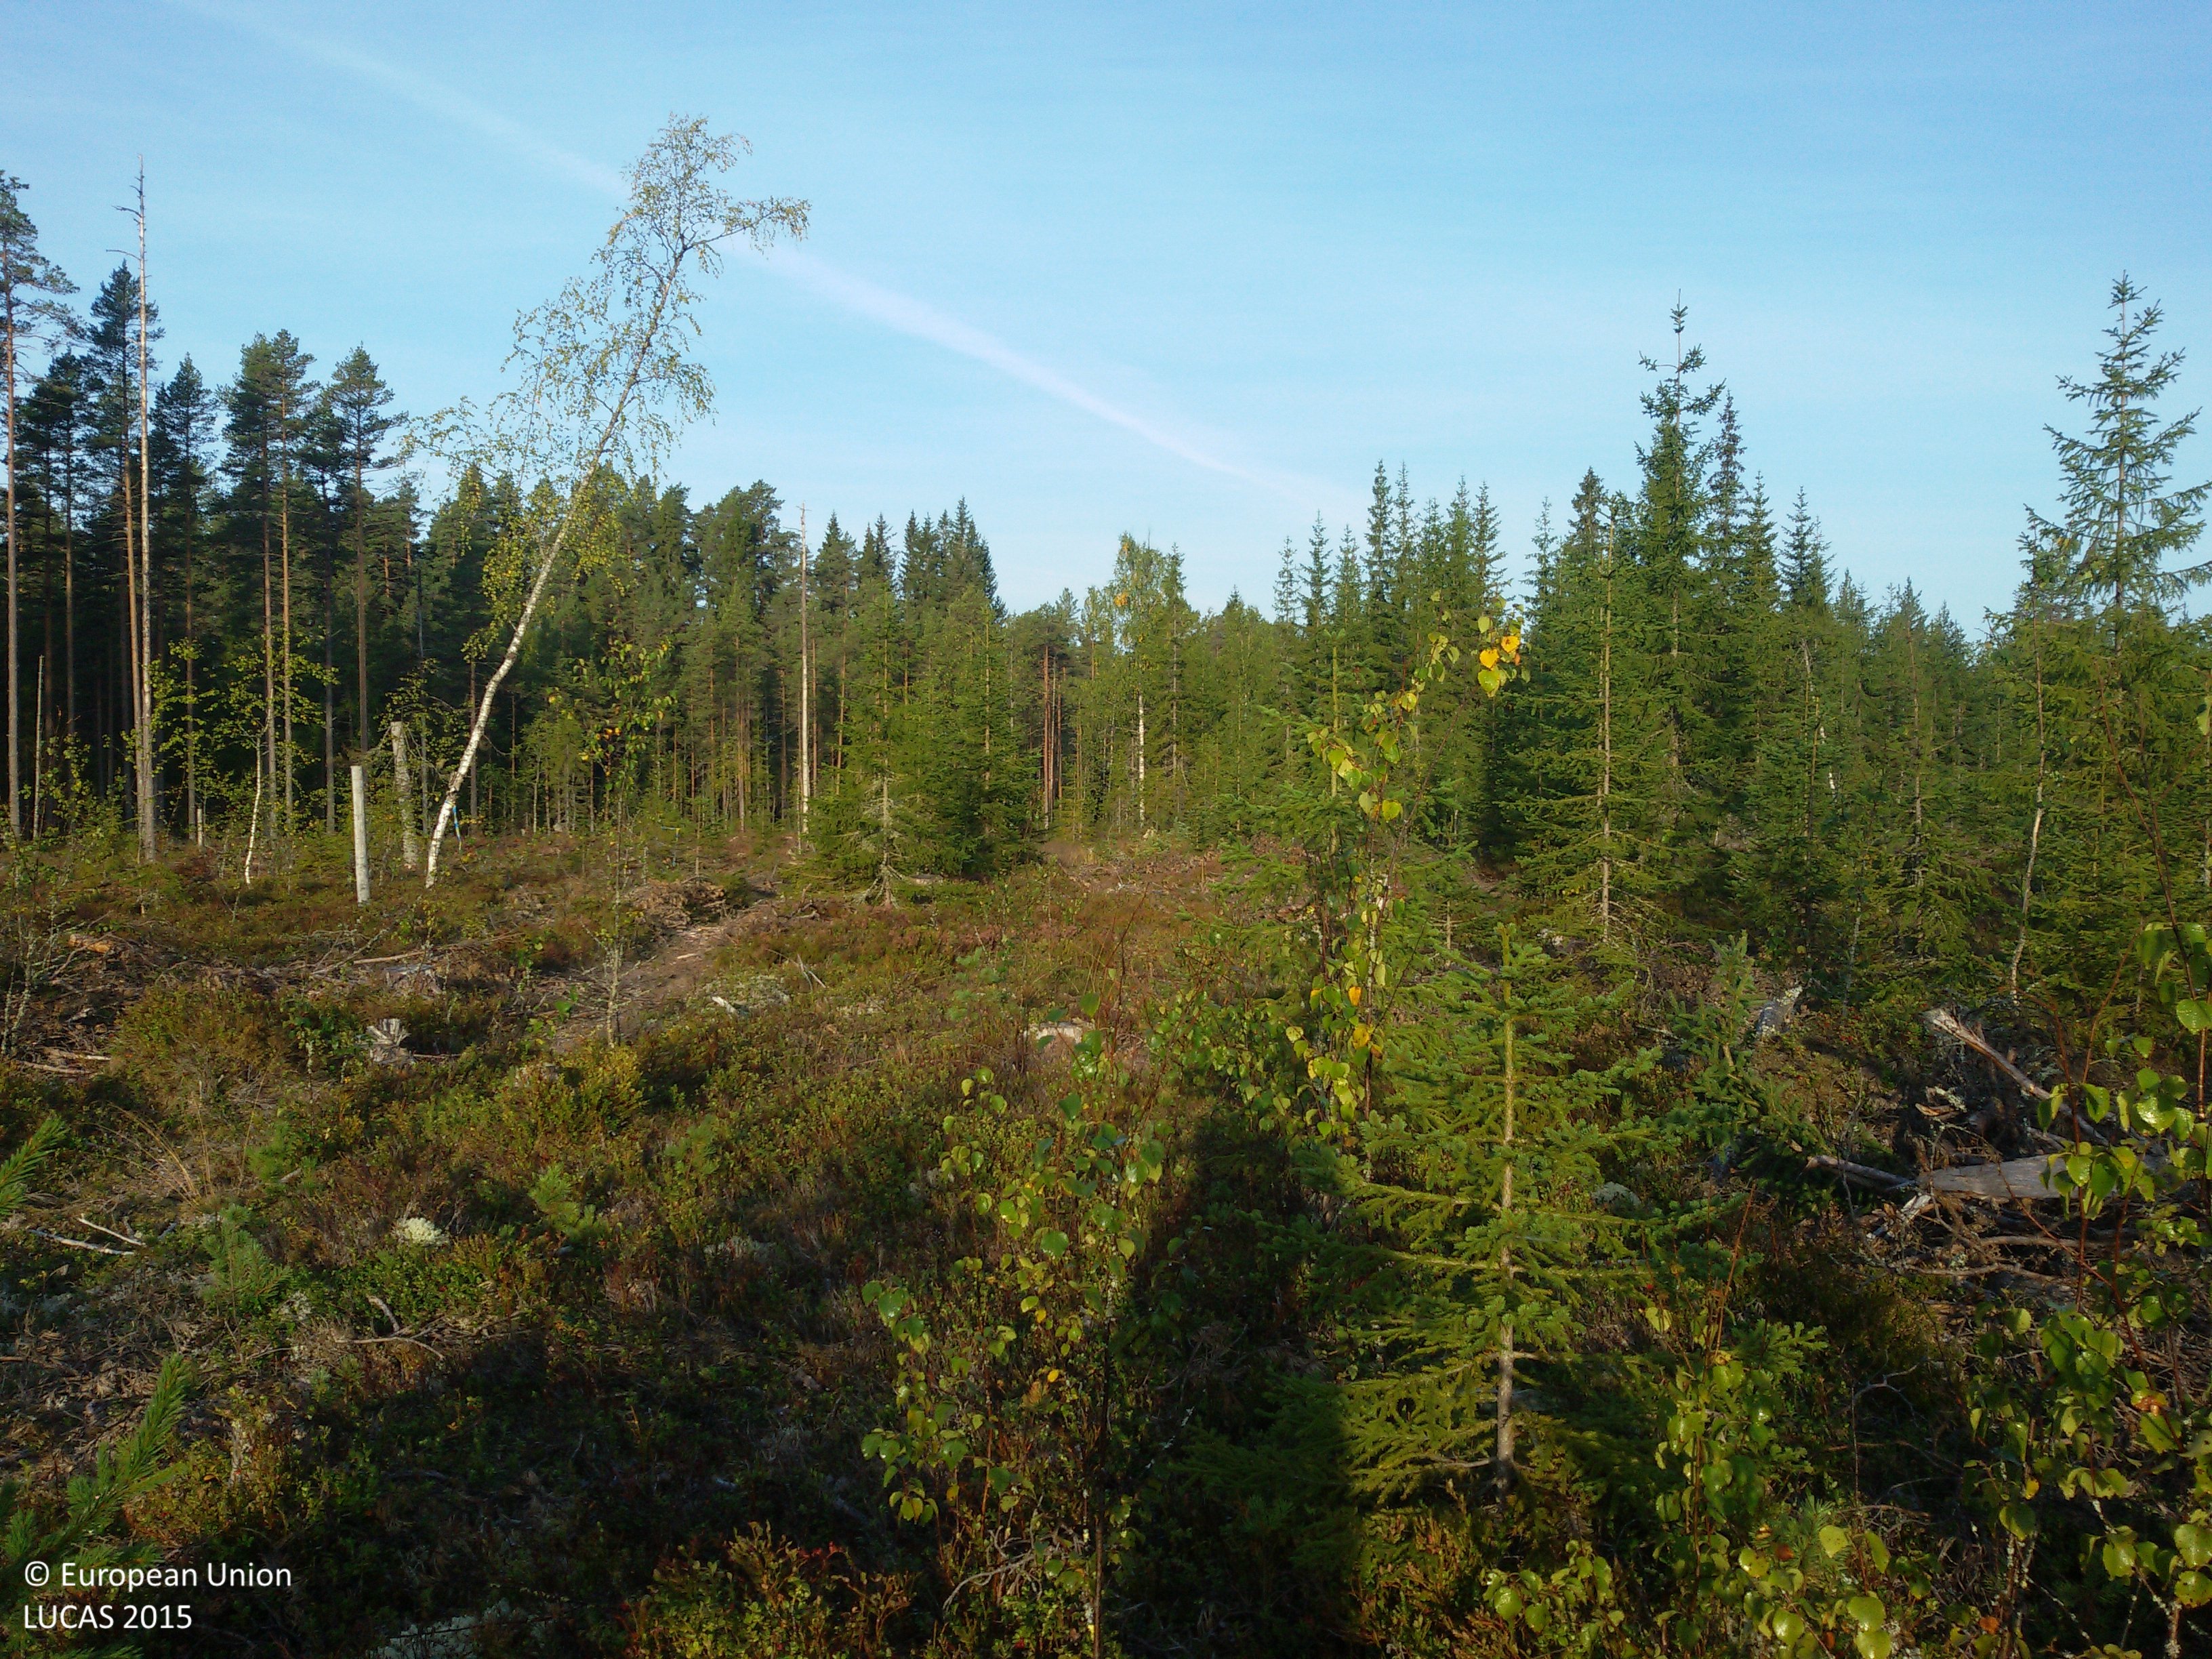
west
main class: Woodland
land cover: Spruce dominated coniferous woodland
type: boreal forest
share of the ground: 25 - 50 %
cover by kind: herbaceous plants 40 %, lichens and mosses 30 %, coniferous forest trees 25 %, broadleaved forest trees 5 %
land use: Forestry
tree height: < 5 m
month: September
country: SE
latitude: 61.0112
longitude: 15.0358
